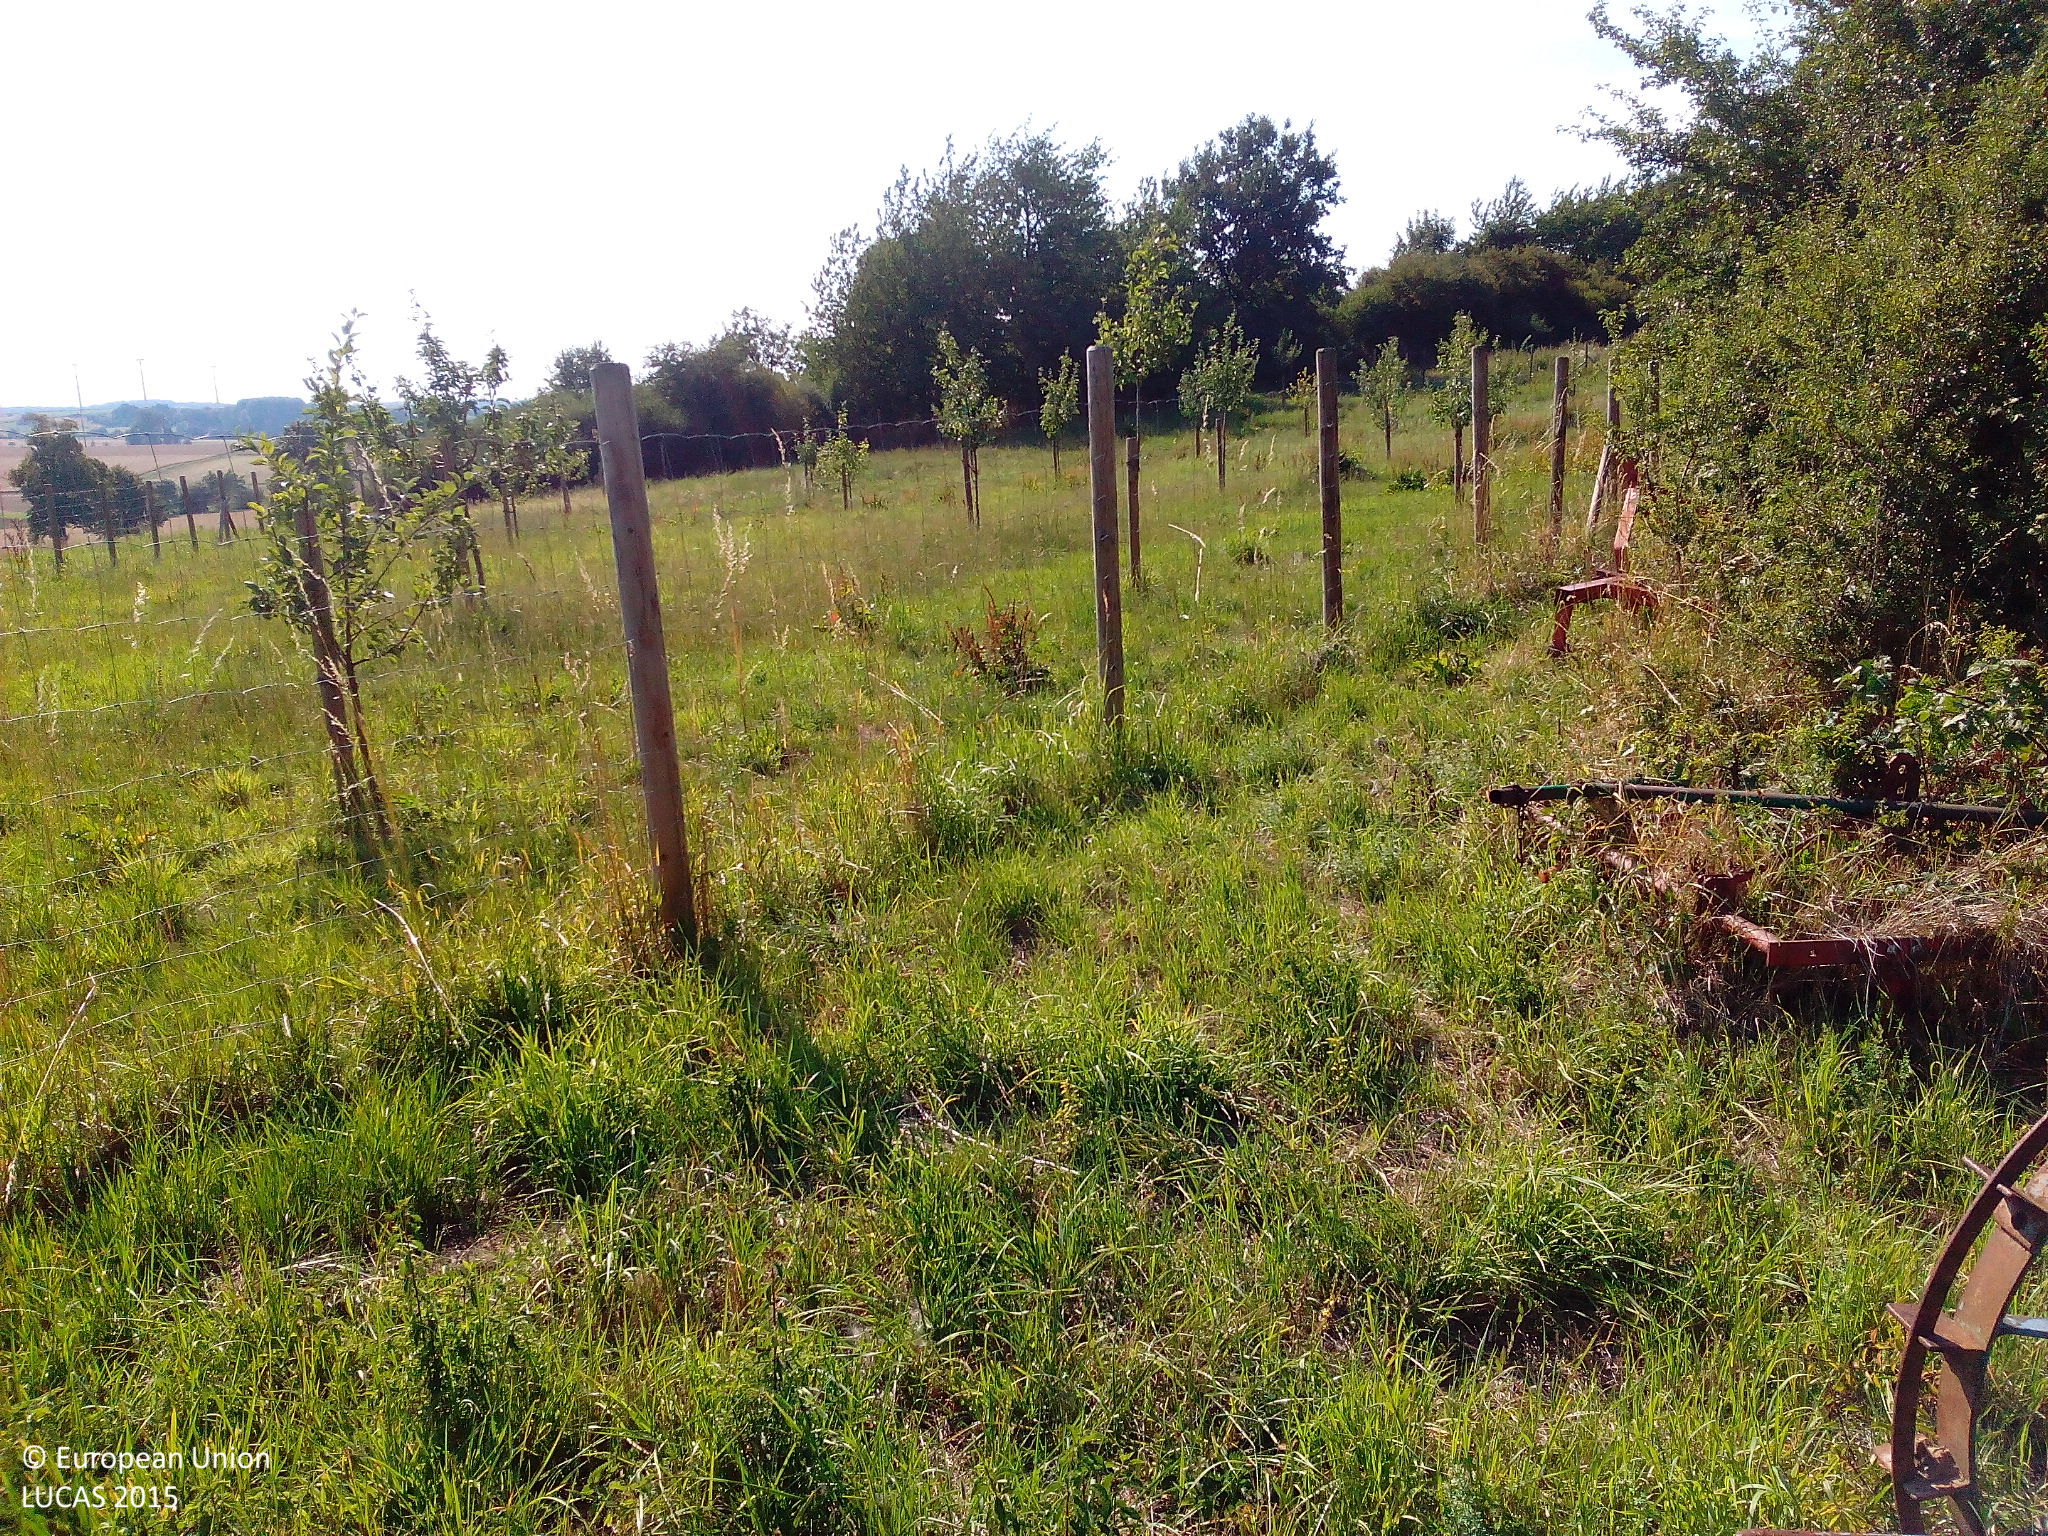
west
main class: Grassland
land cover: Grassland without tree/shrub cover
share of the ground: > 75 %
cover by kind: herbaceous plants 100 %
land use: Agriculture (excluding fallow land and kitchen gardens)
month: August
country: DE
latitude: 50.7572
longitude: 9.2489
